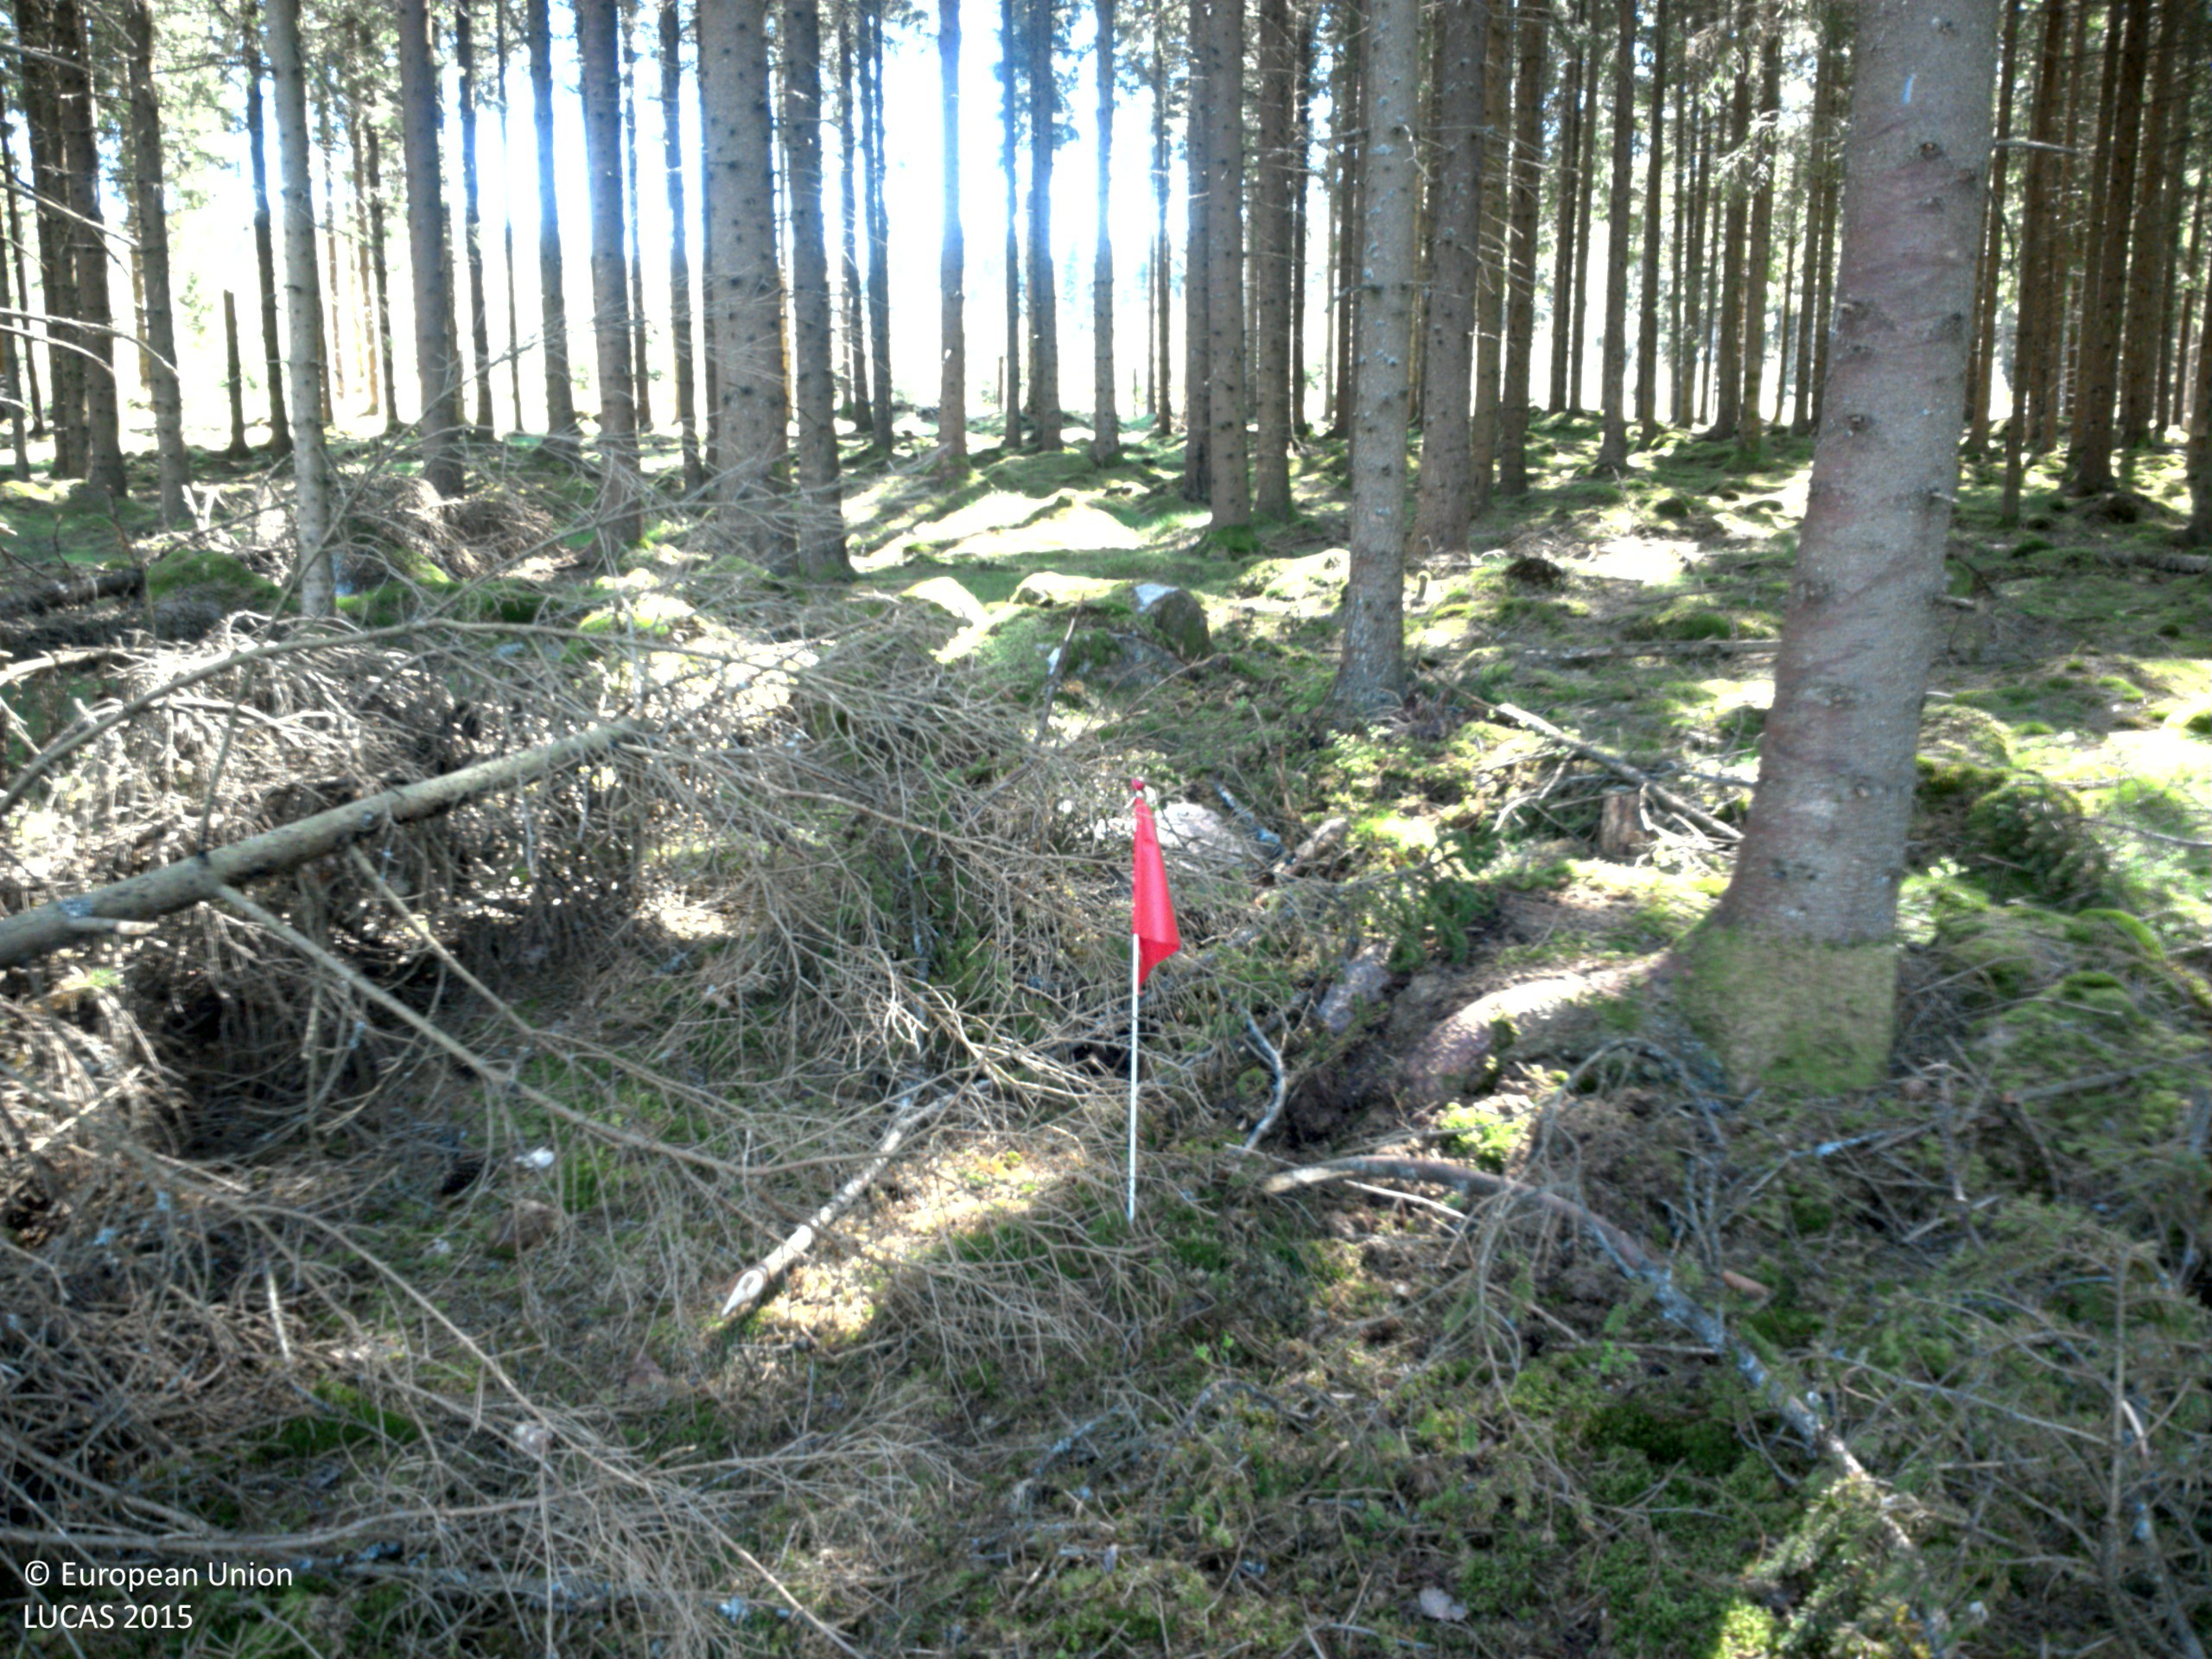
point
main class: Woodland
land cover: Spruce dominated coniferous woodland
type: boreal forest
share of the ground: > 75 %
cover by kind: coniferous forest trees 90 %, lichens and mosses 10 %
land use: Forestry
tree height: > 5 m
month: May
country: SE
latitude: 57.5385
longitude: 12.9859
